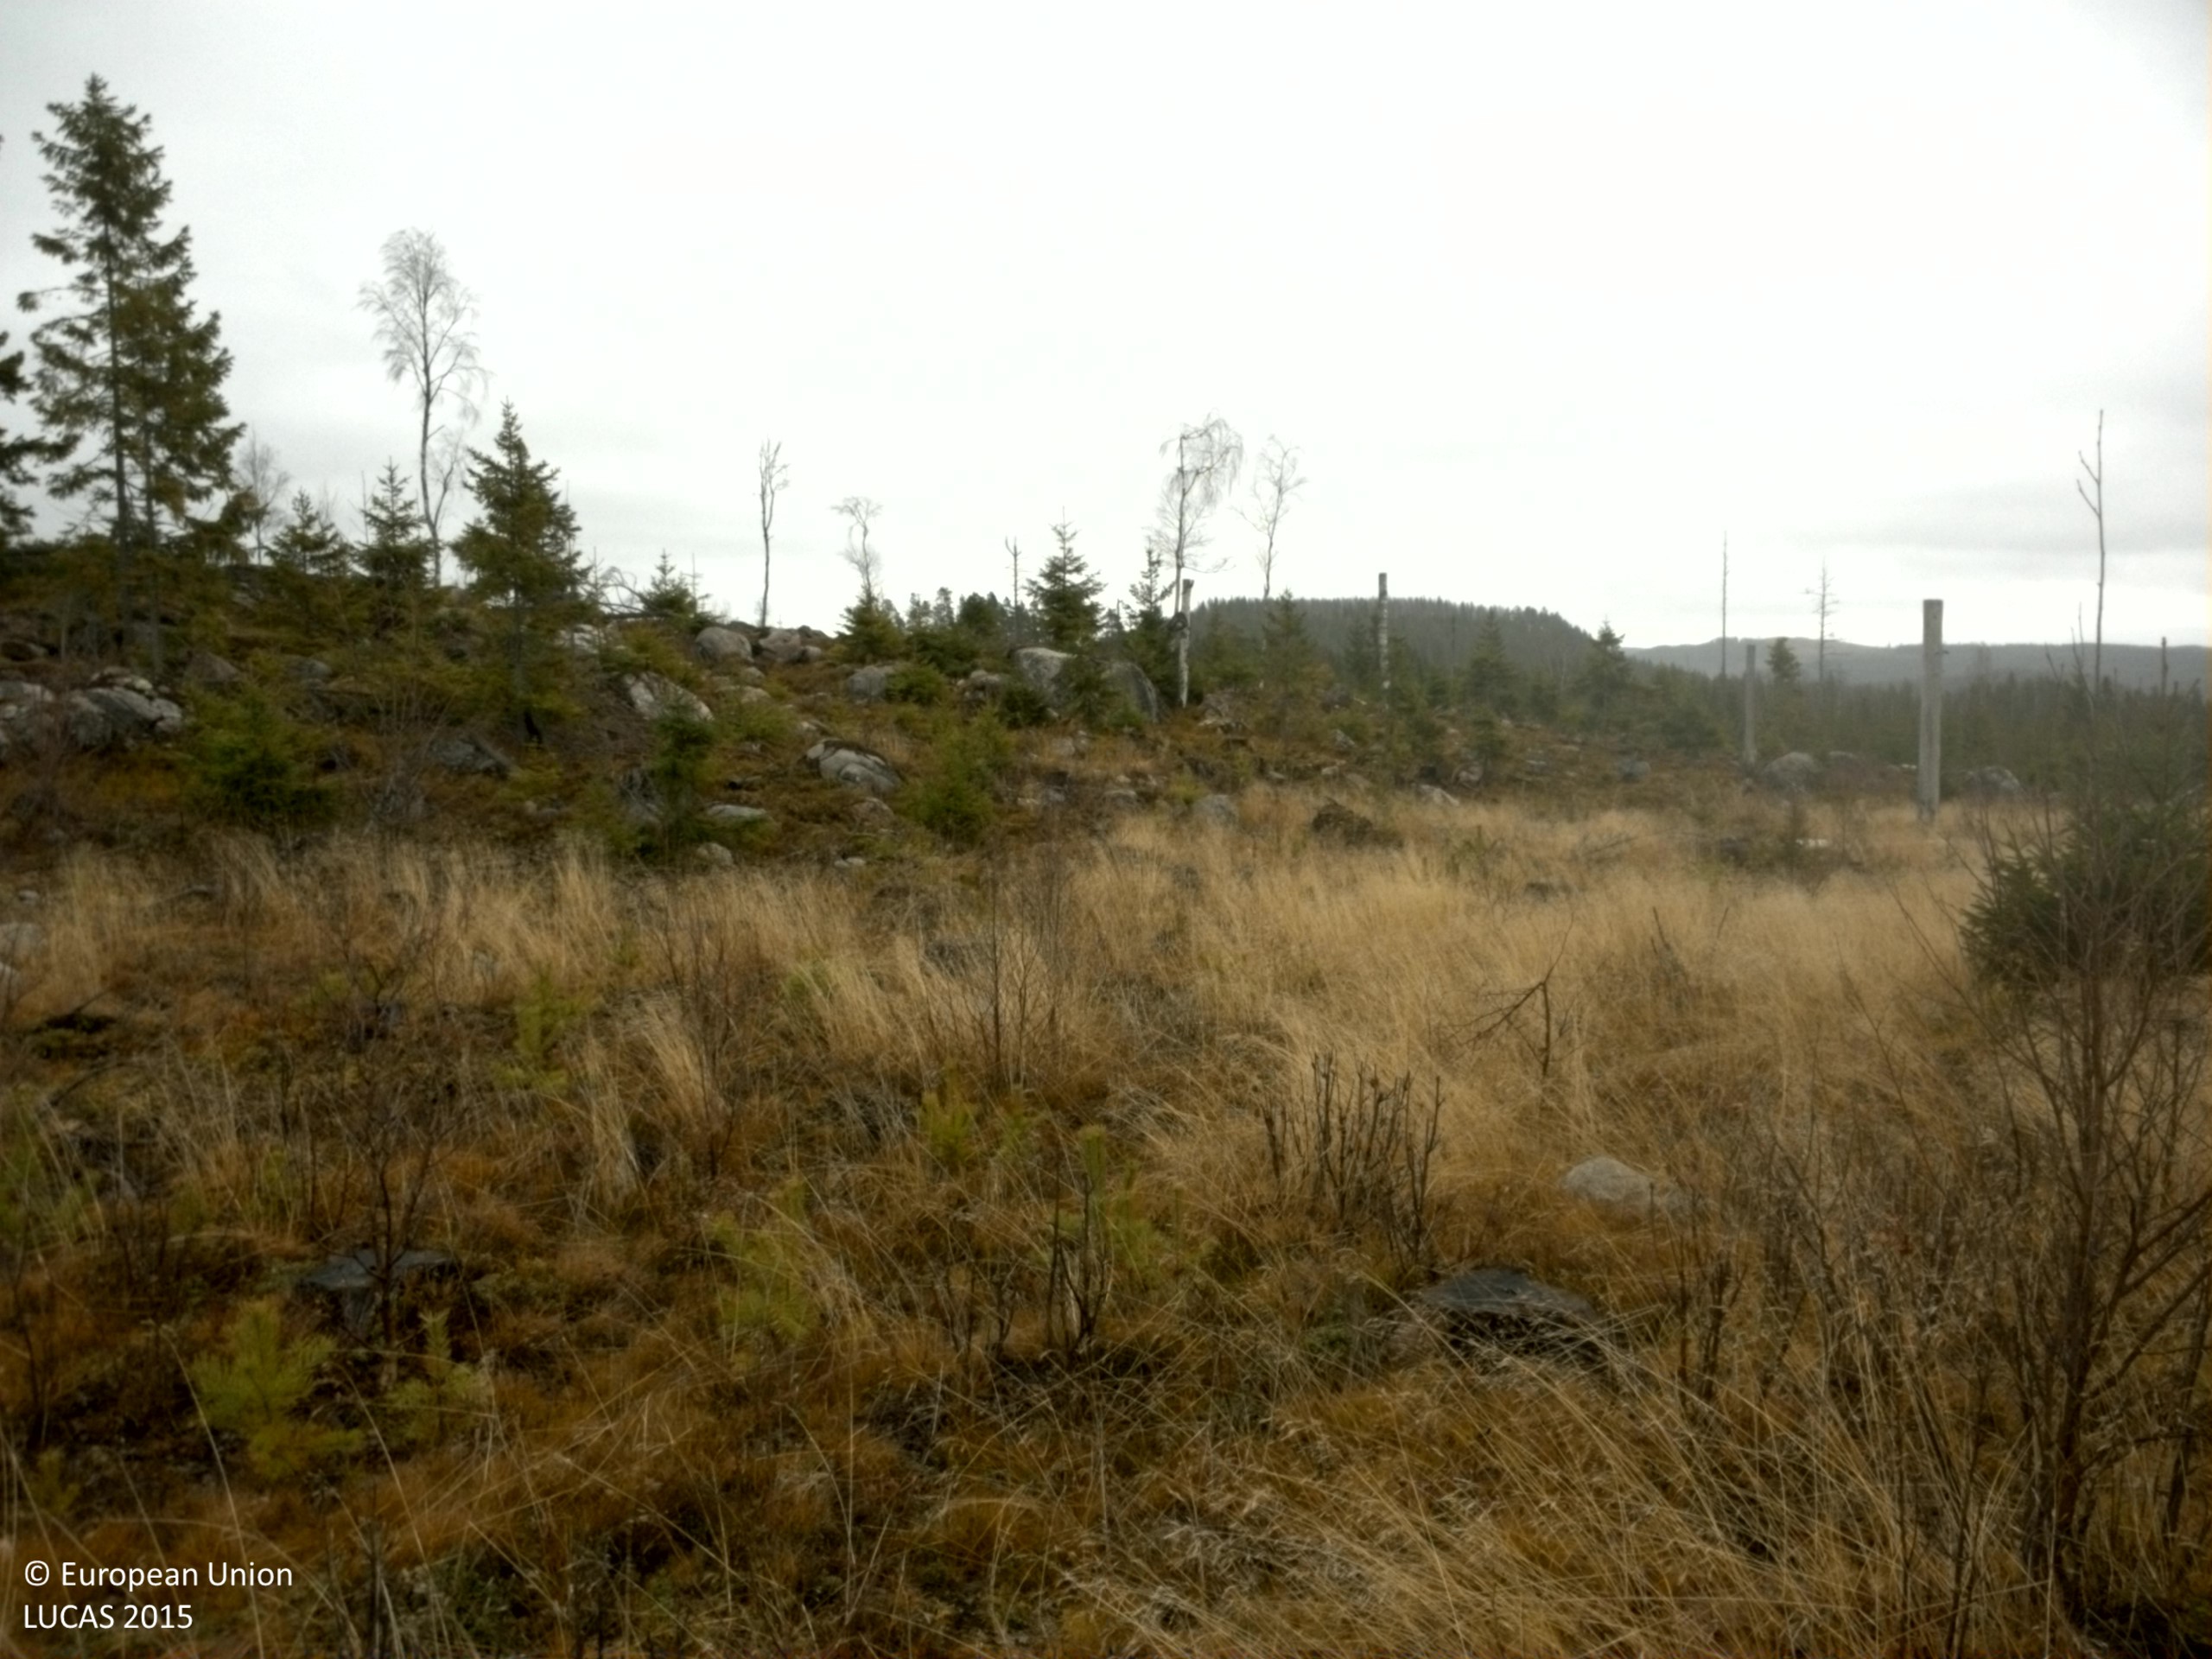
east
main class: Woodland
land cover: Other mixed woodland
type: boreal forest
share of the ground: 10 - 25 %
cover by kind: herbaceous plants 40 %, lichens and mosses 20 %, shrubs 15 %, coniferous forest trees 10 %, broadleaved forest trees 10 %, consolidated bare surface 5 %
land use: Forestry
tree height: < 5 m
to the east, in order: Other mixed woodland; Spruce dominated mixed woodland; Other mixed woodland; Spruce dominated coniferous woodland; Spruce dominated mixed woodland
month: November
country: SE
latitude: 61.6009
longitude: 16.5616
